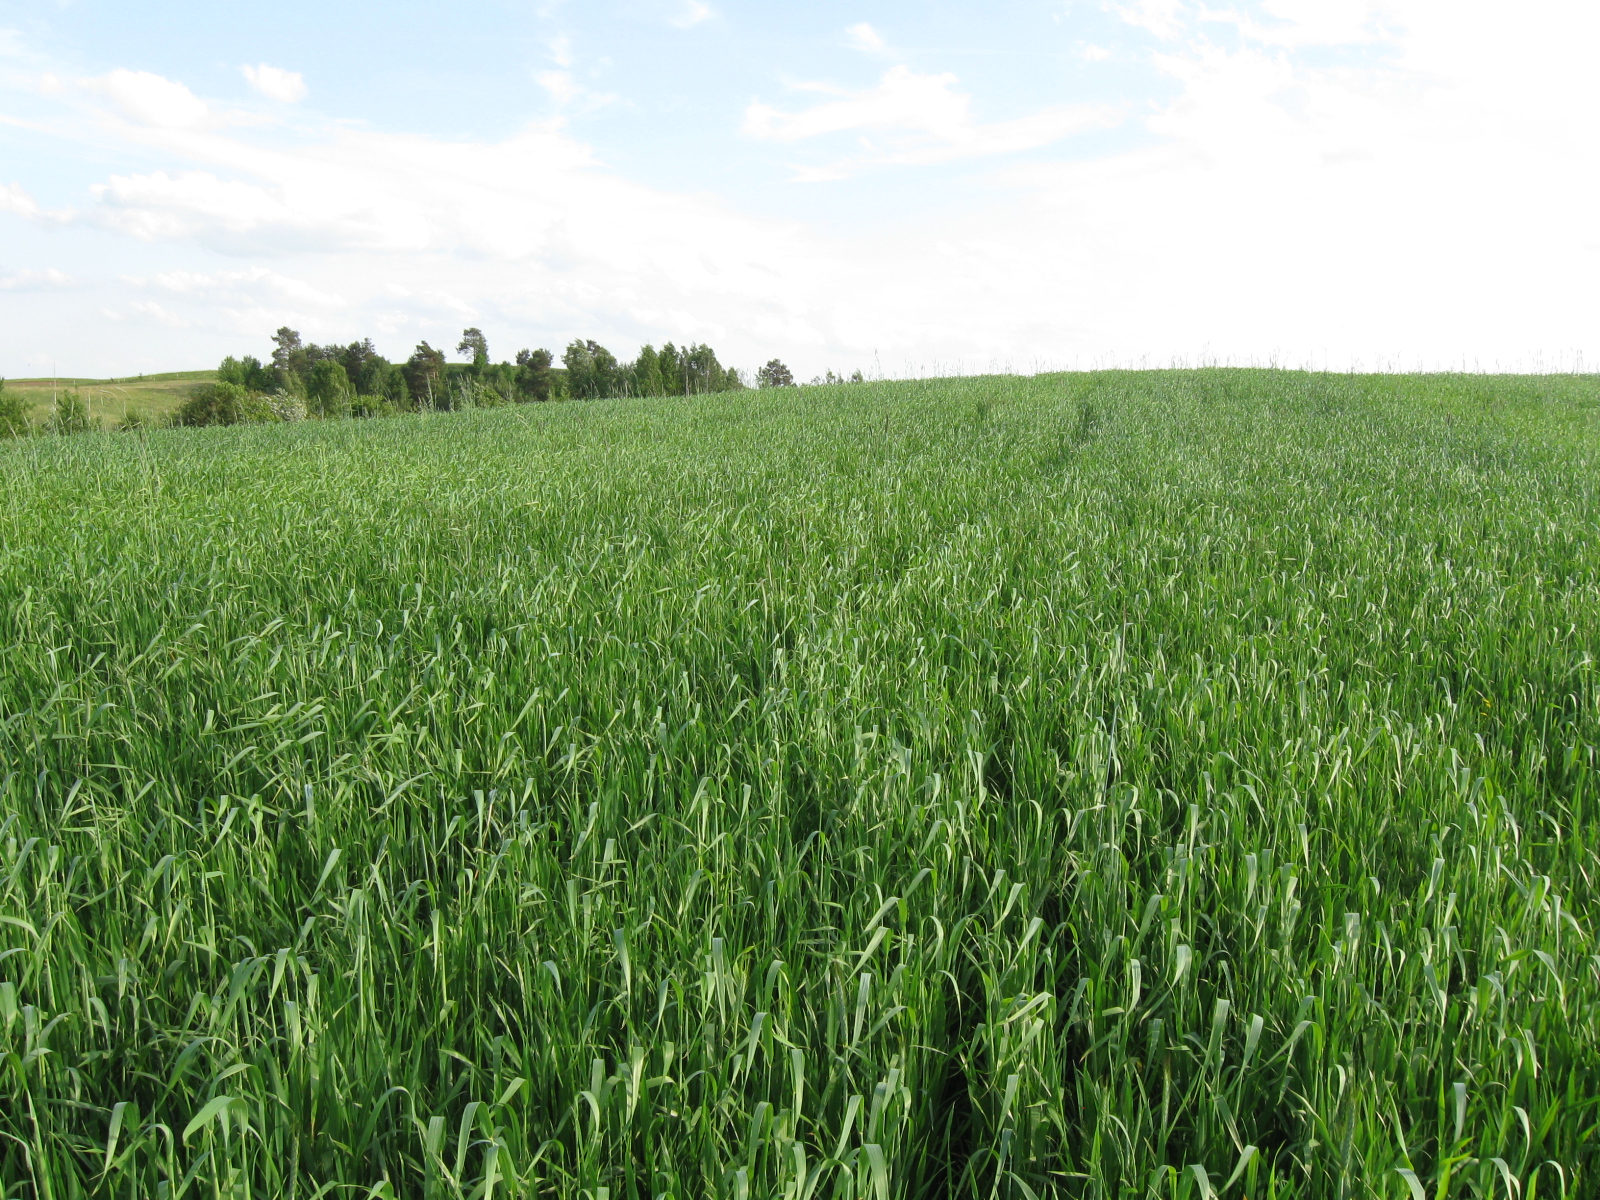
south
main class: Cropland
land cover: Common wheat
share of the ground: > 75 %
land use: Agriculture (excluding fallow land and kitchen gardens)
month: June
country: LT
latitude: 54.2323
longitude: 23.6314
